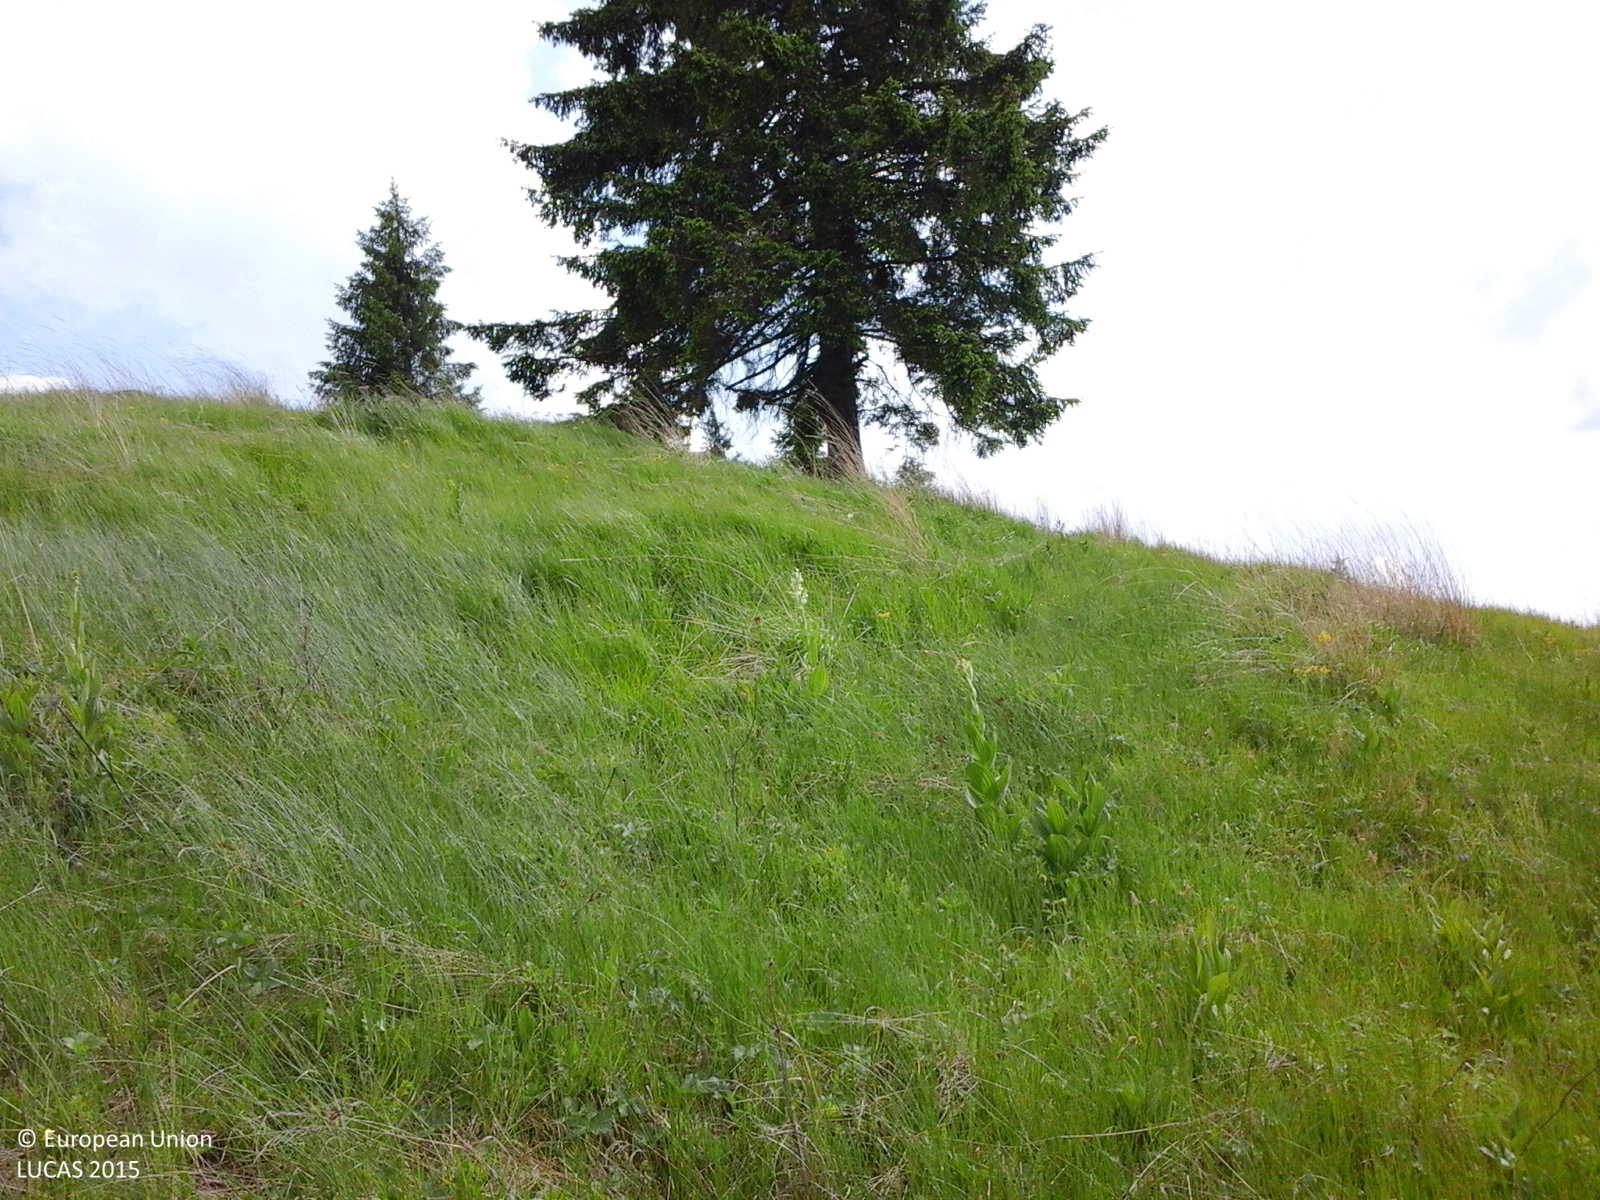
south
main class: Grassland
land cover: Grassland without tree/shrub cover
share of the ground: > 75 %
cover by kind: herbaceous plants 100 %
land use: Agriculture (excluding fallow land and kitchen gardens)
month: June
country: RO
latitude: 47.1831
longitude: 25.4331
